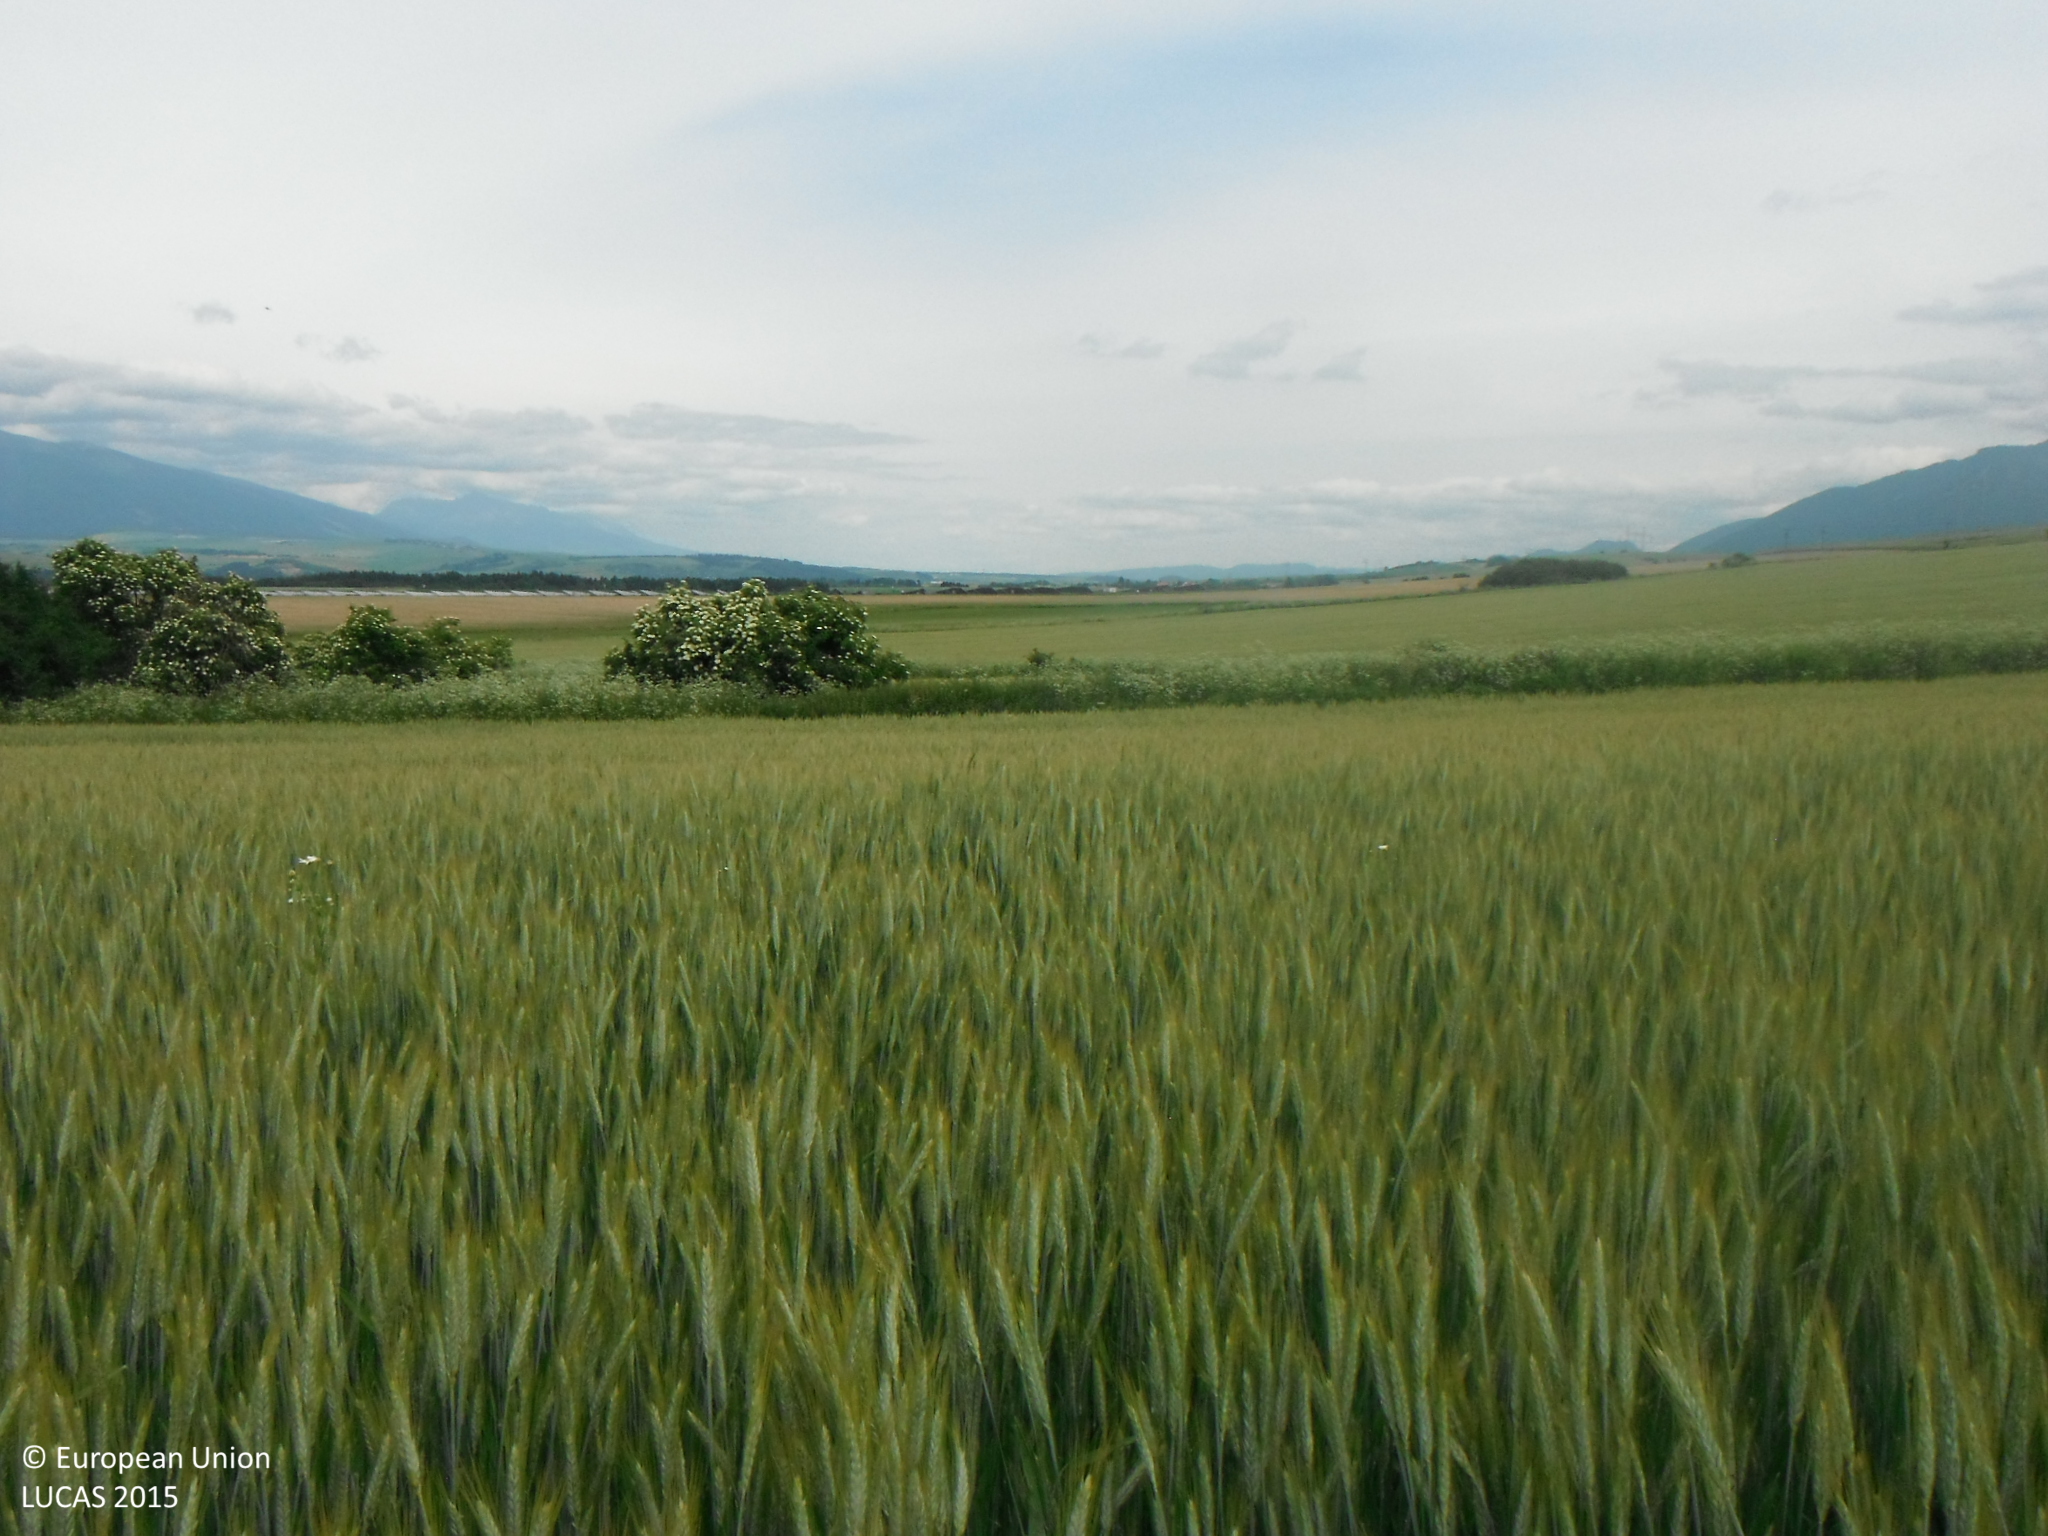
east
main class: Cropland
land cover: Rye
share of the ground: > 75 %
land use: Agriculture (excluding fallow land and kitchen gardens)
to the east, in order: Rye; Spontaneously vegetated surfaces; Rye; Spontaneously vegetated surfaces; Ditches and canals; Spontaneously vegetated surfaces; Rye
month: June
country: SK
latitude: 49.0793
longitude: 19.5138
